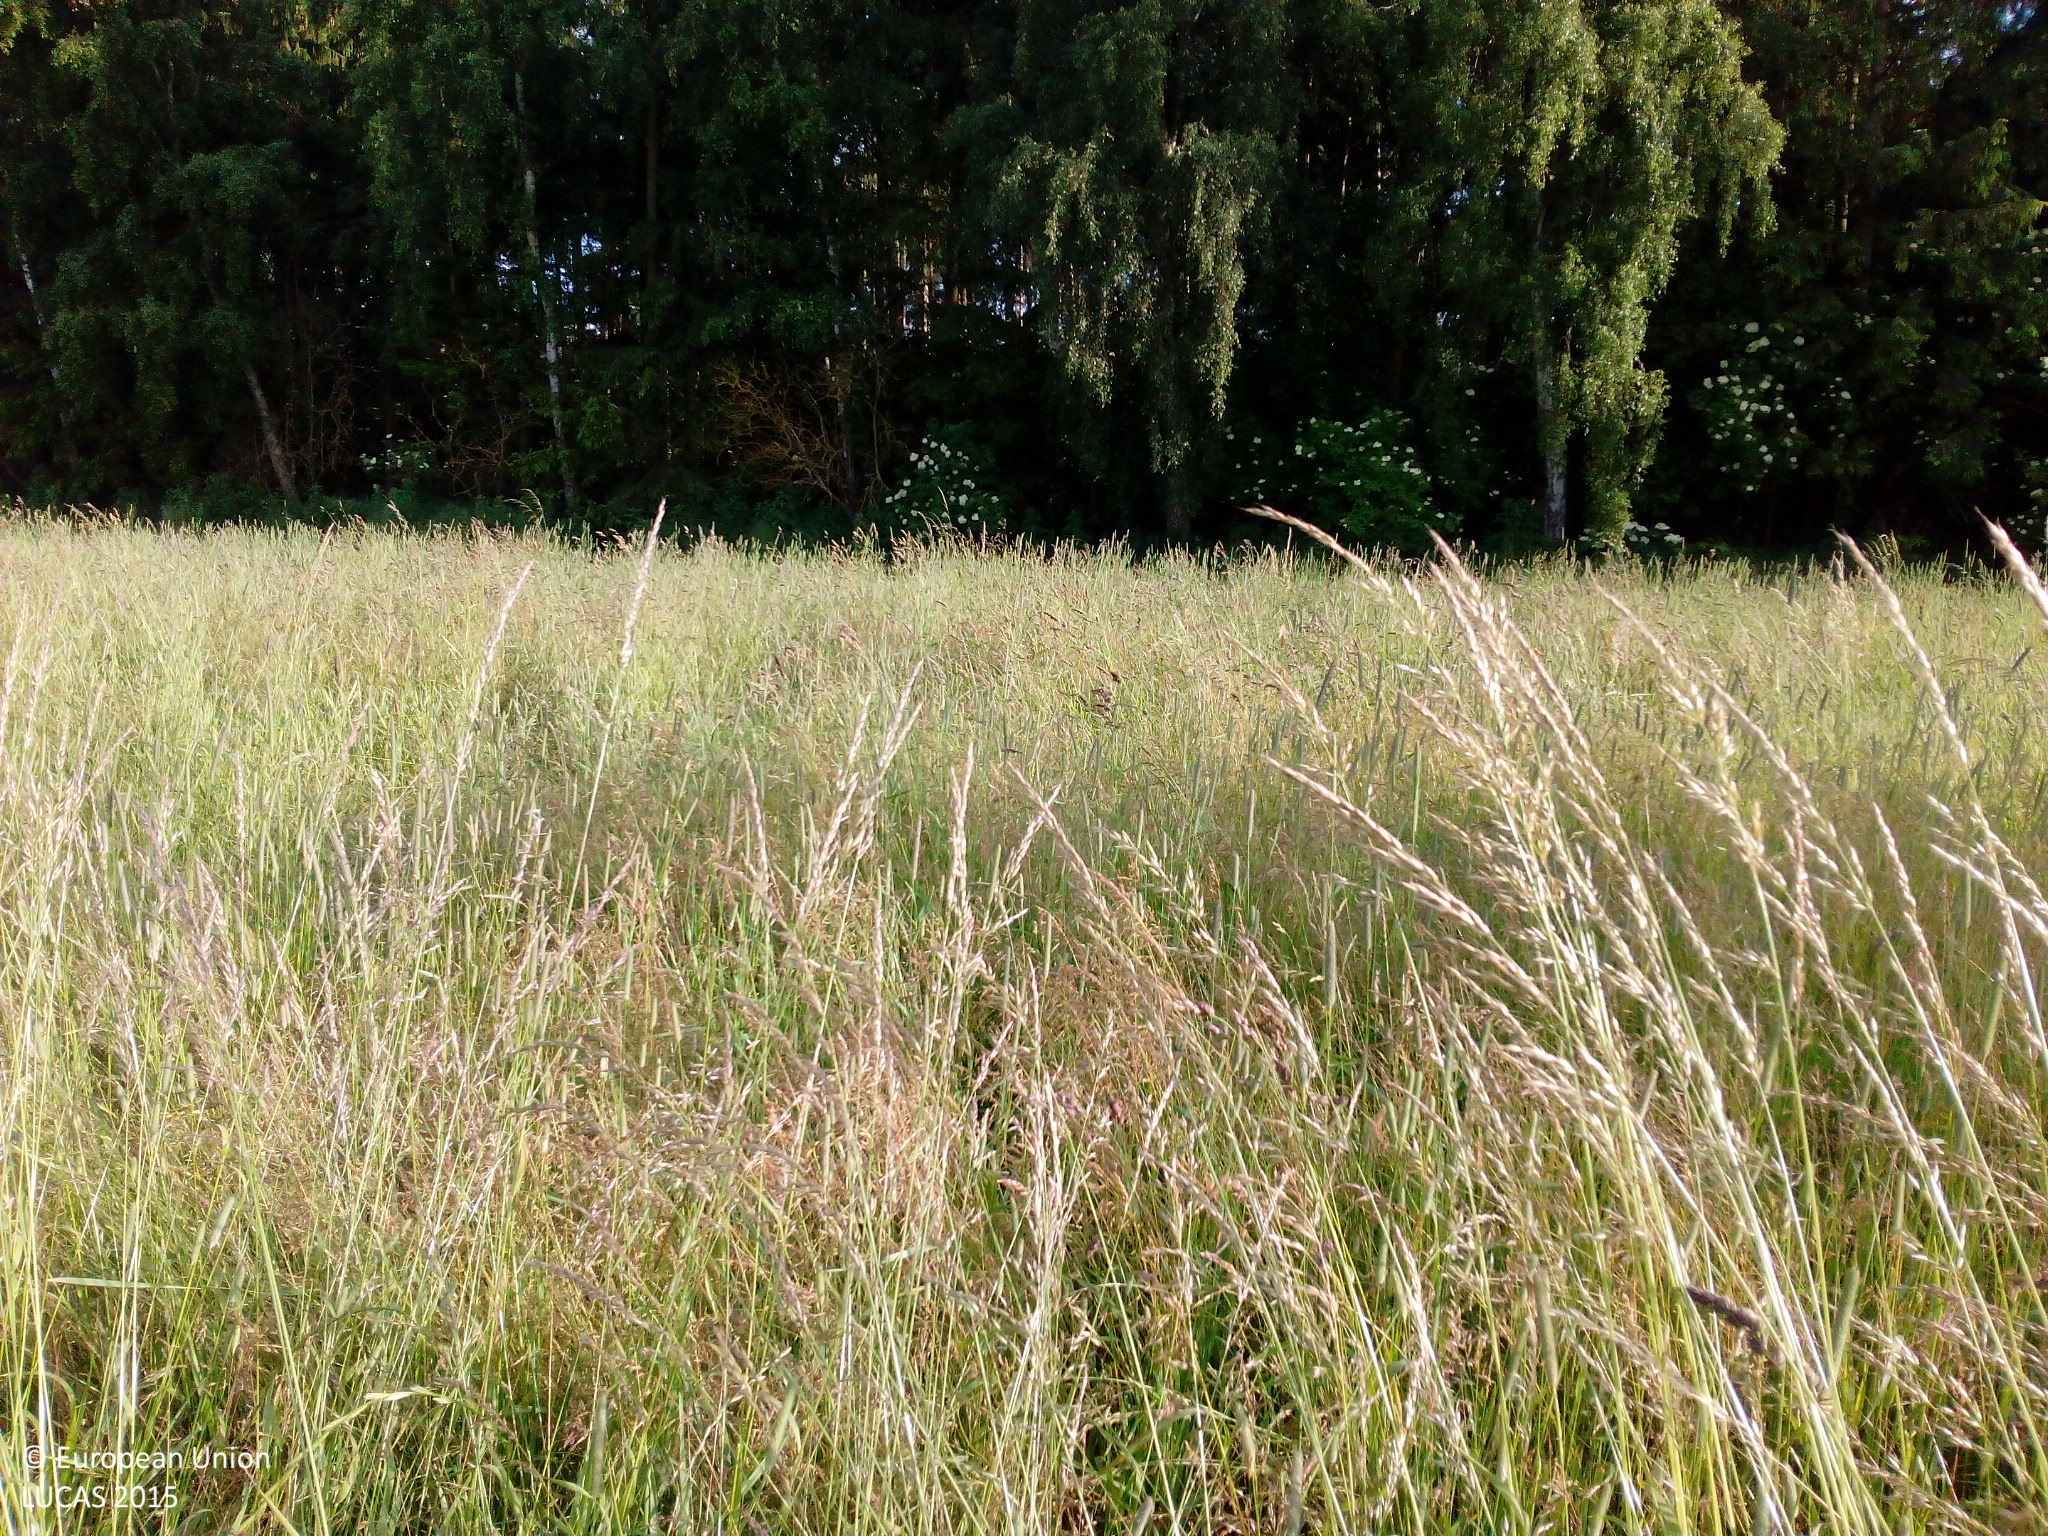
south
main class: Grassland
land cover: Grassland without tree/shrub cover
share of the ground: > 75 %
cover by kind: herbaceous plants 100 %
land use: Agriculture (excluding fallow land and kitchen gardens)
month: June
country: DK
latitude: 55.0591
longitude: 11.8931
